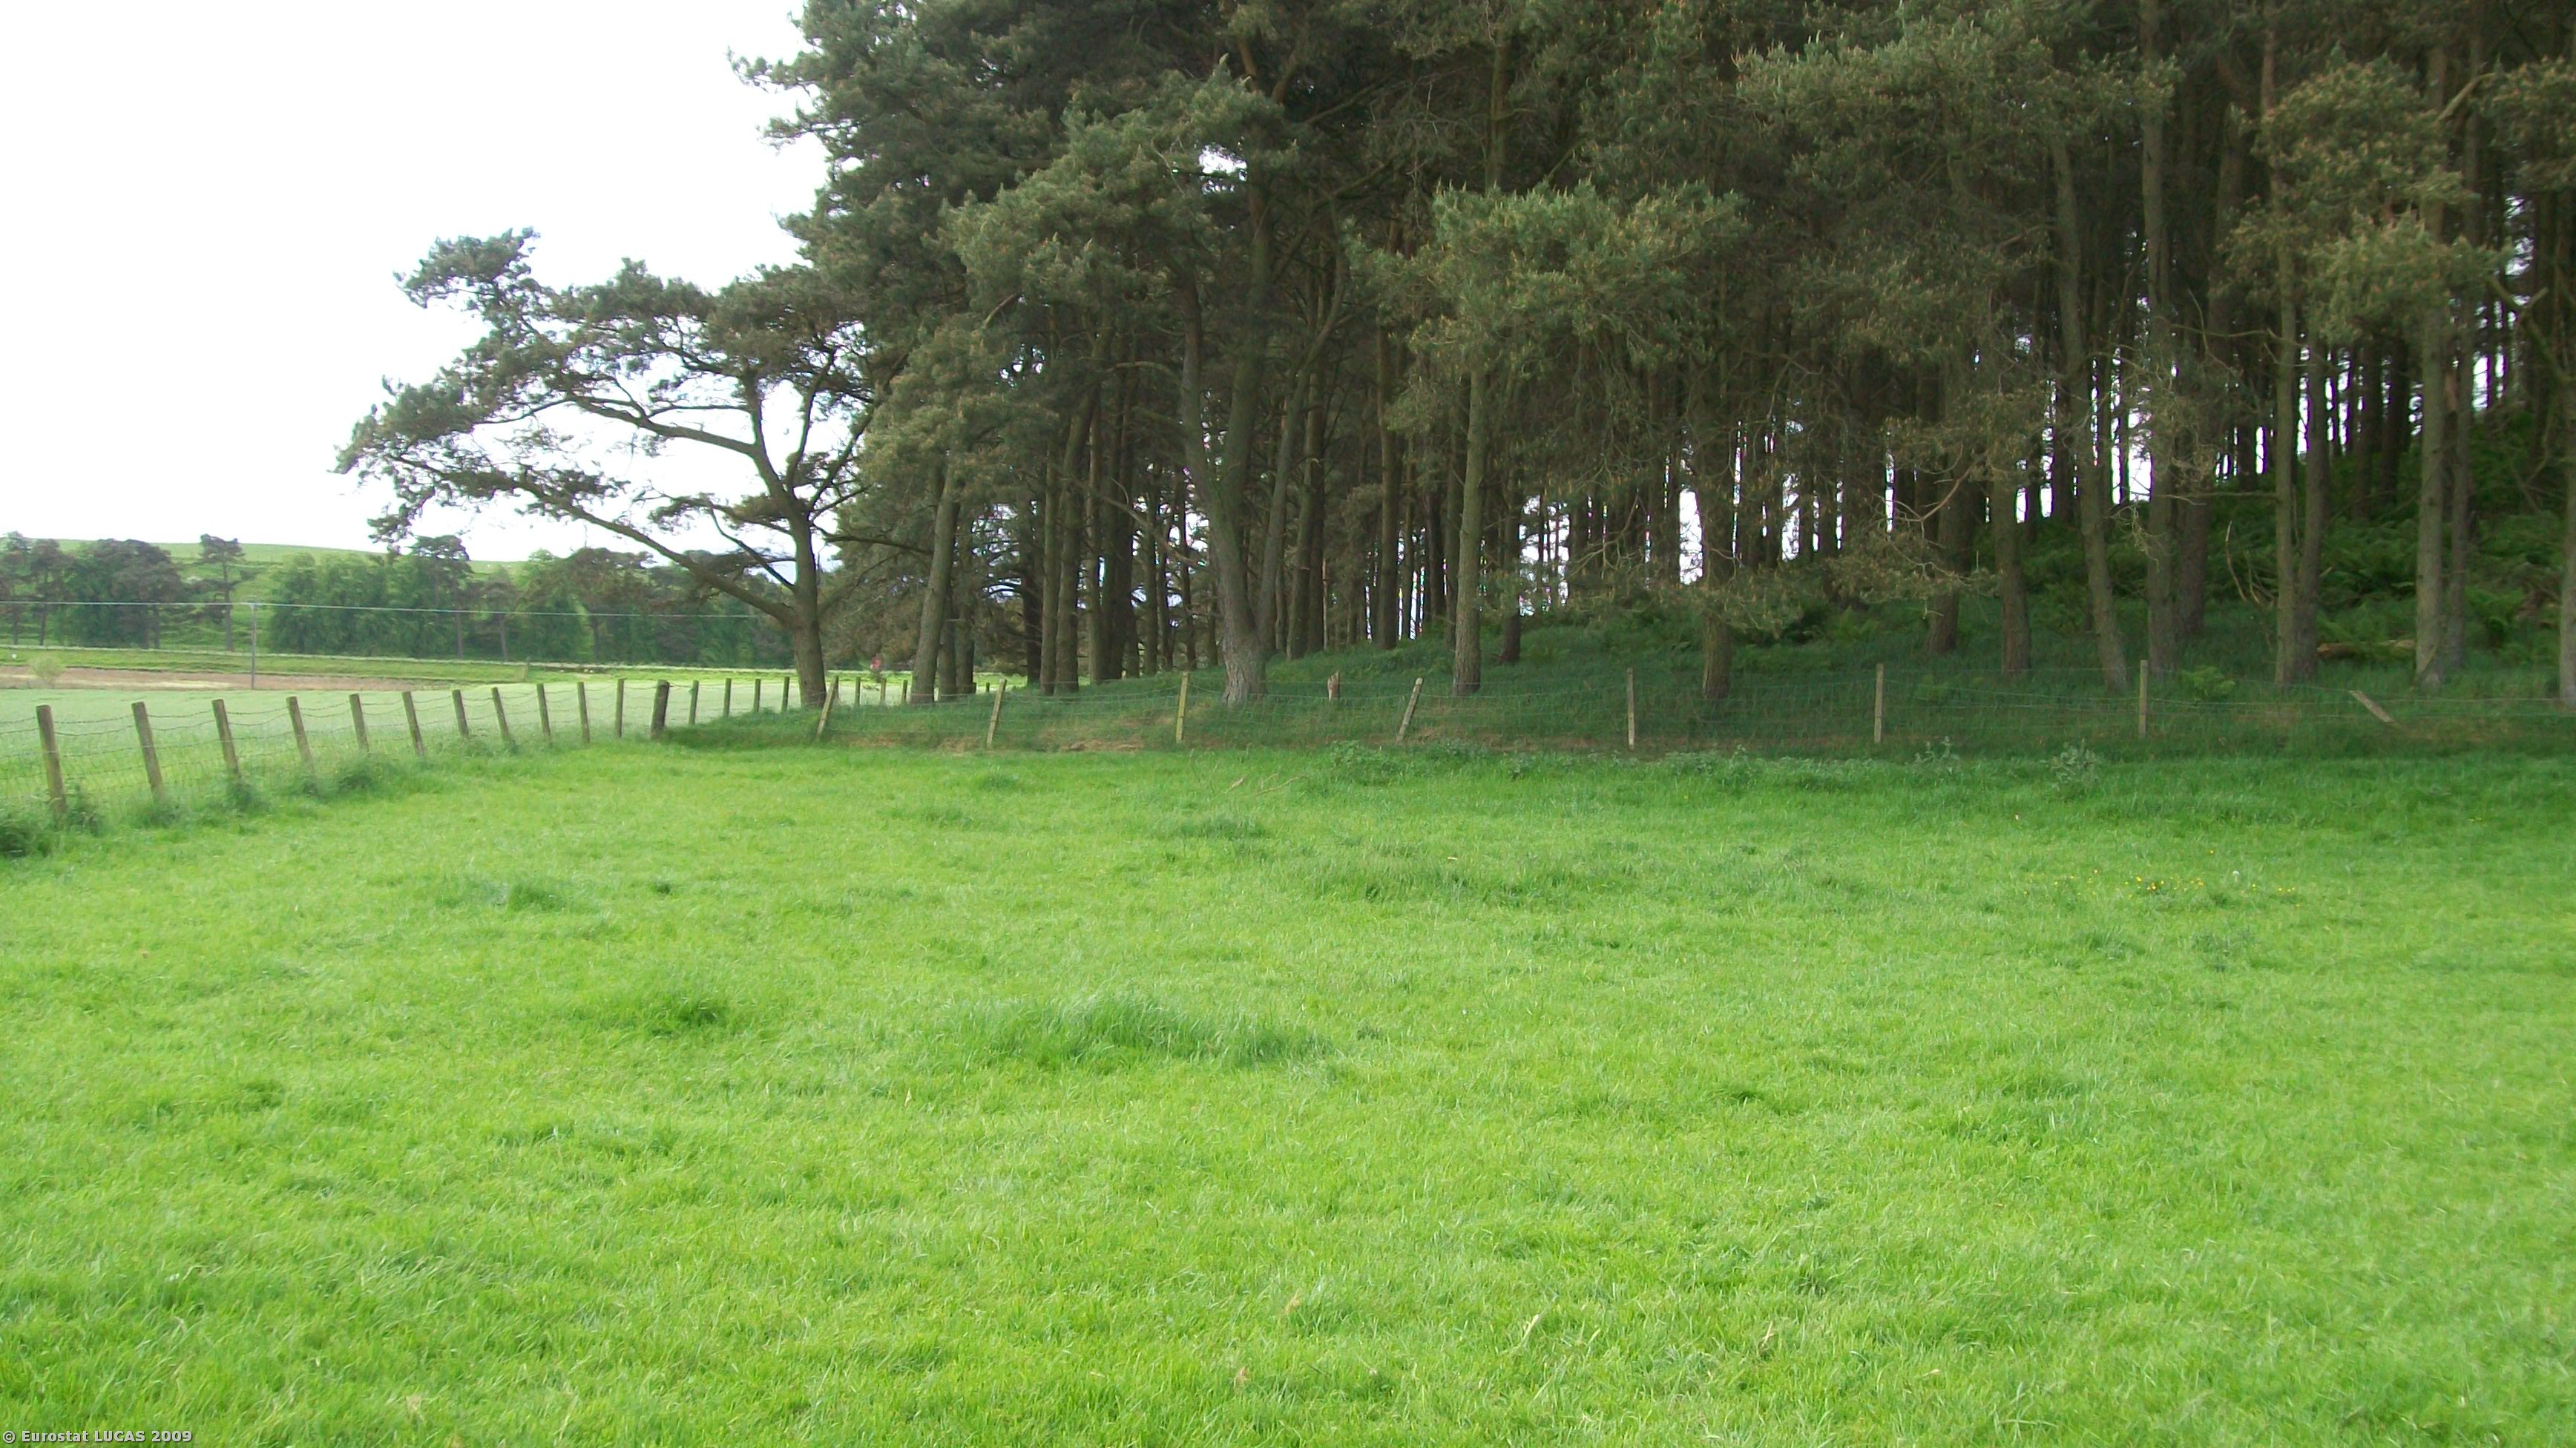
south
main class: Grassland
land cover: Grassland without tree/shrub cover
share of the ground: > 75 %
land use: Agriculture (excluding fallow land and kitchen gardens)
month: June
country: GB
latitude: 55.6978
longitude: -3.5882
